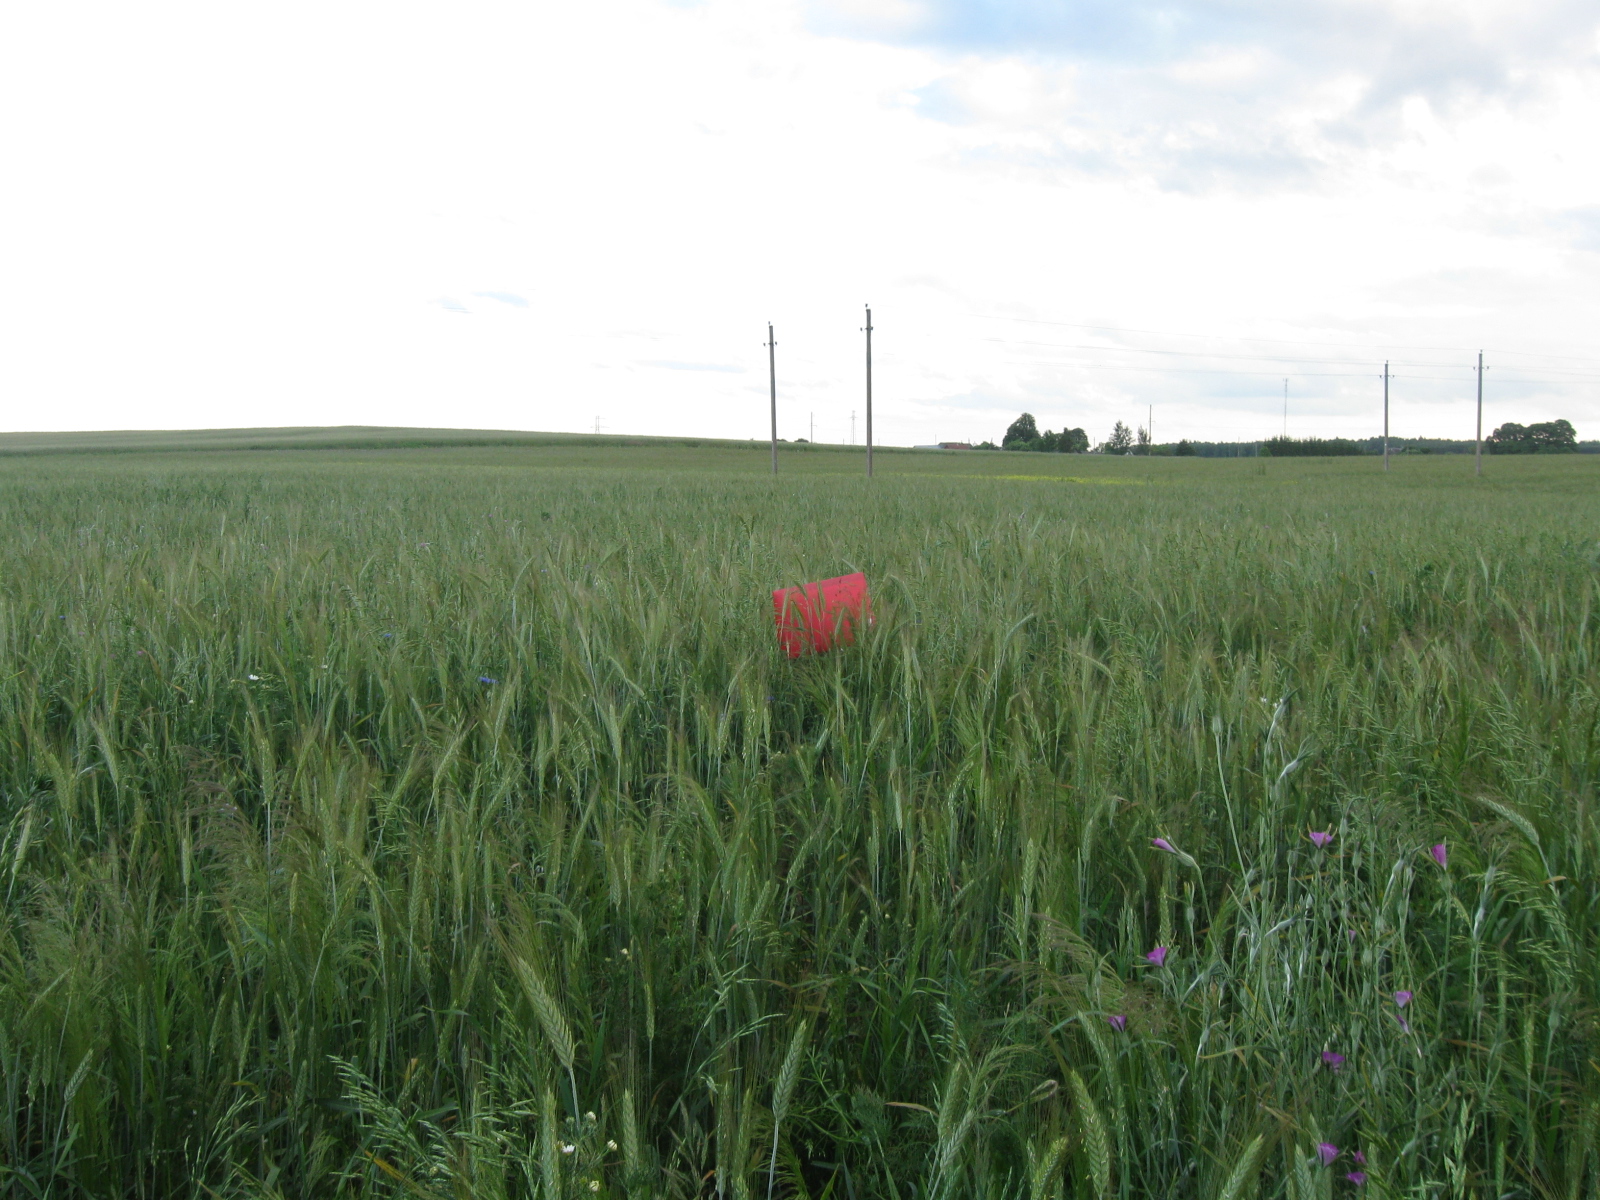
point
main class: Cropland
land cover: Temporary grasslands
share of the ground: > 75 %
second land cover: Triticale
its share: 10 - 25 %
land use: Agriculture (excluding fallow land and kitchen gardens)
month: June
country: LT
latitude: 54.1376
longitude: 24.7578
